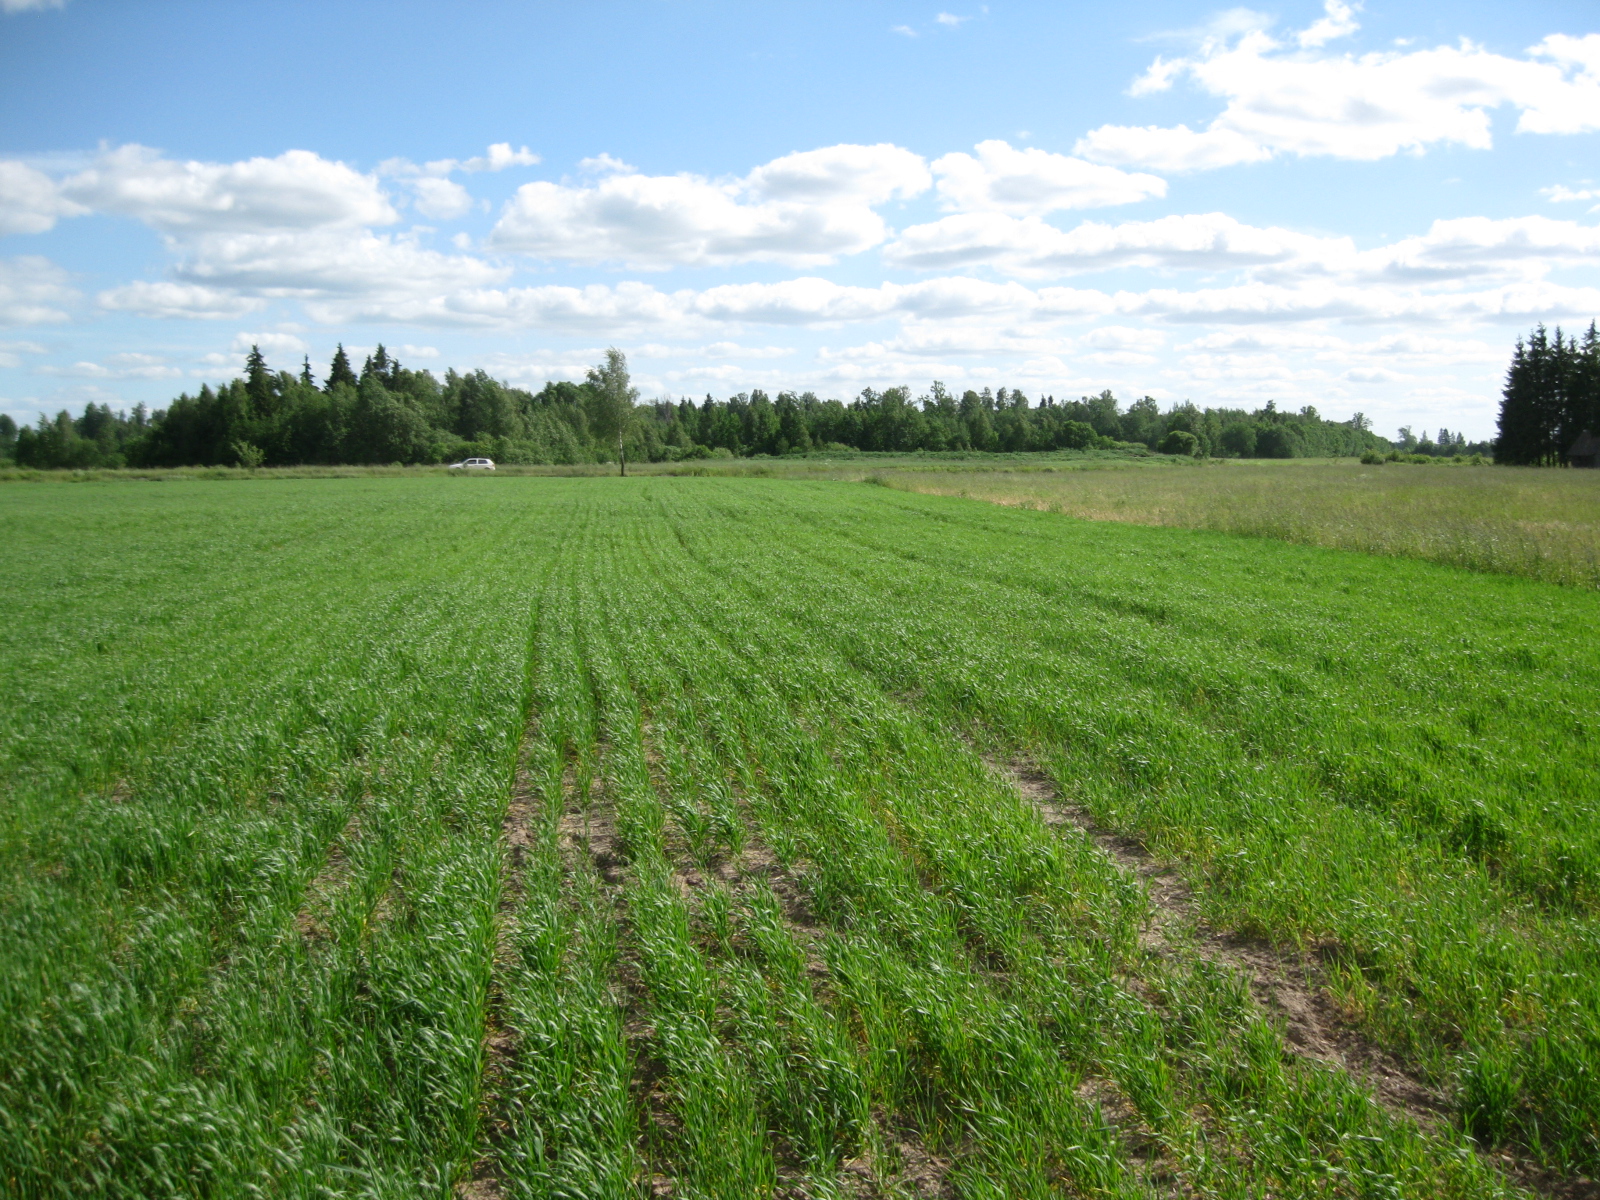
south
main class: Cropland
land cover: Triticale
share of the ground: > 75 %
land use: Agriculture (excluding fallow land and kitchen gardens)
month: June
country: LT
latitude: 55.6274
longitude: 23.5637
